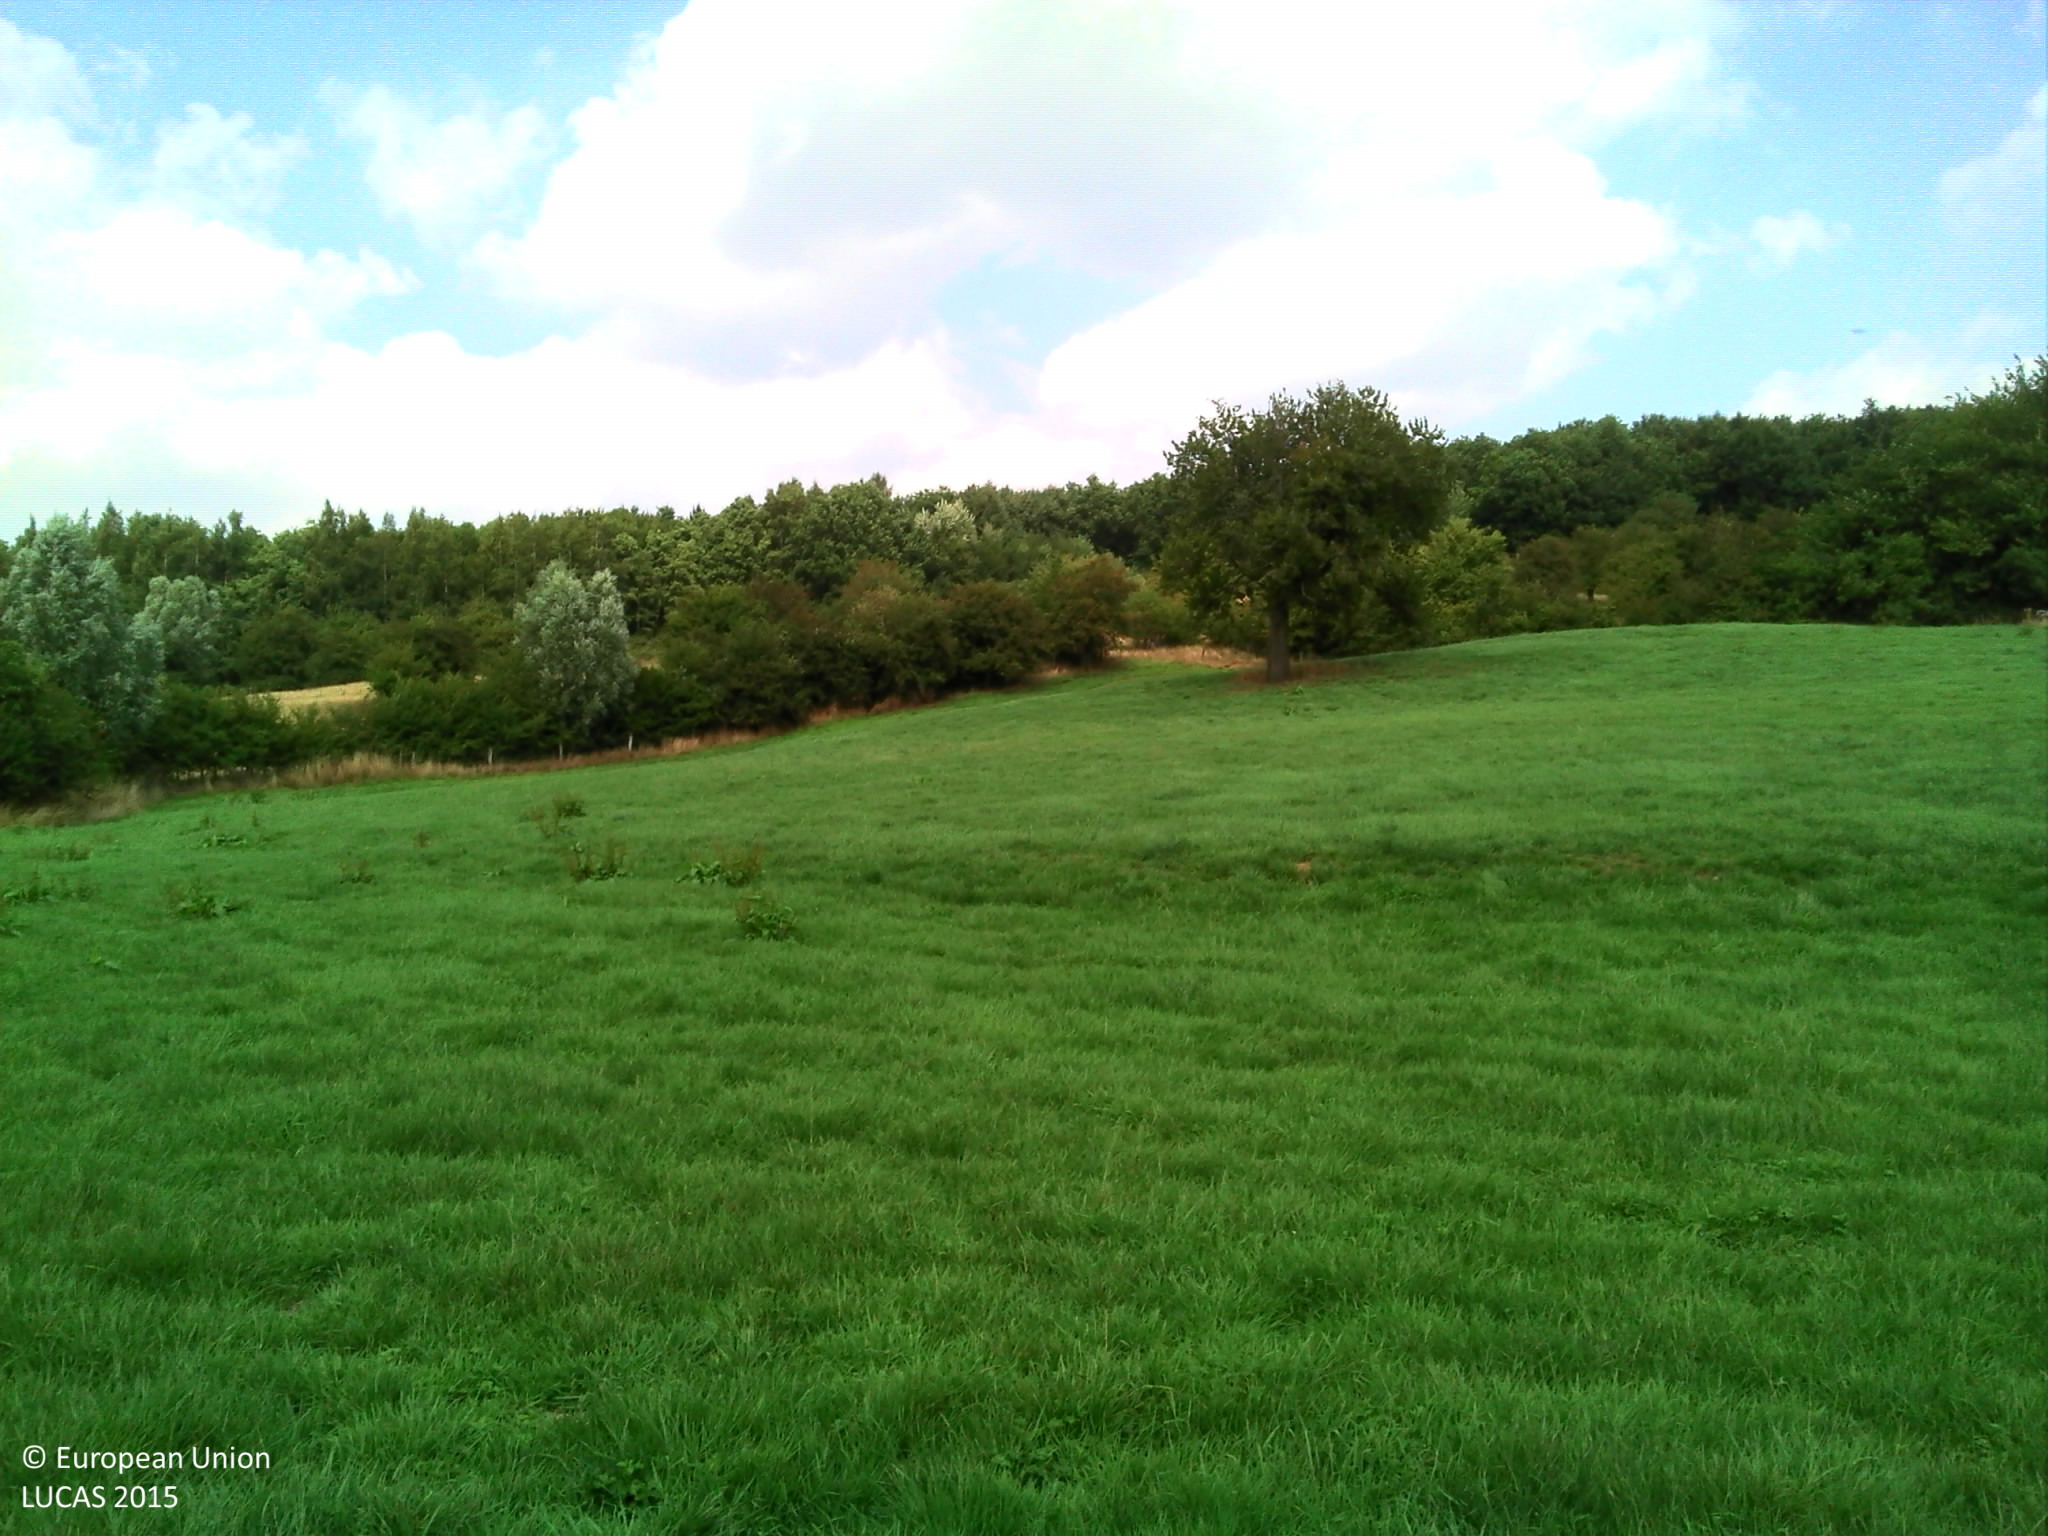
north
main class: Grassland
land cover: Grassland without tree/shrub cover
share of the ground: > 75 %
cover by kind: herbaceous plants 100 %
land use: Agriculture (excluding fallow land and kitchen gardens)
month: August
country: BE
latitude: 50.7671
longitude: 2.7718
